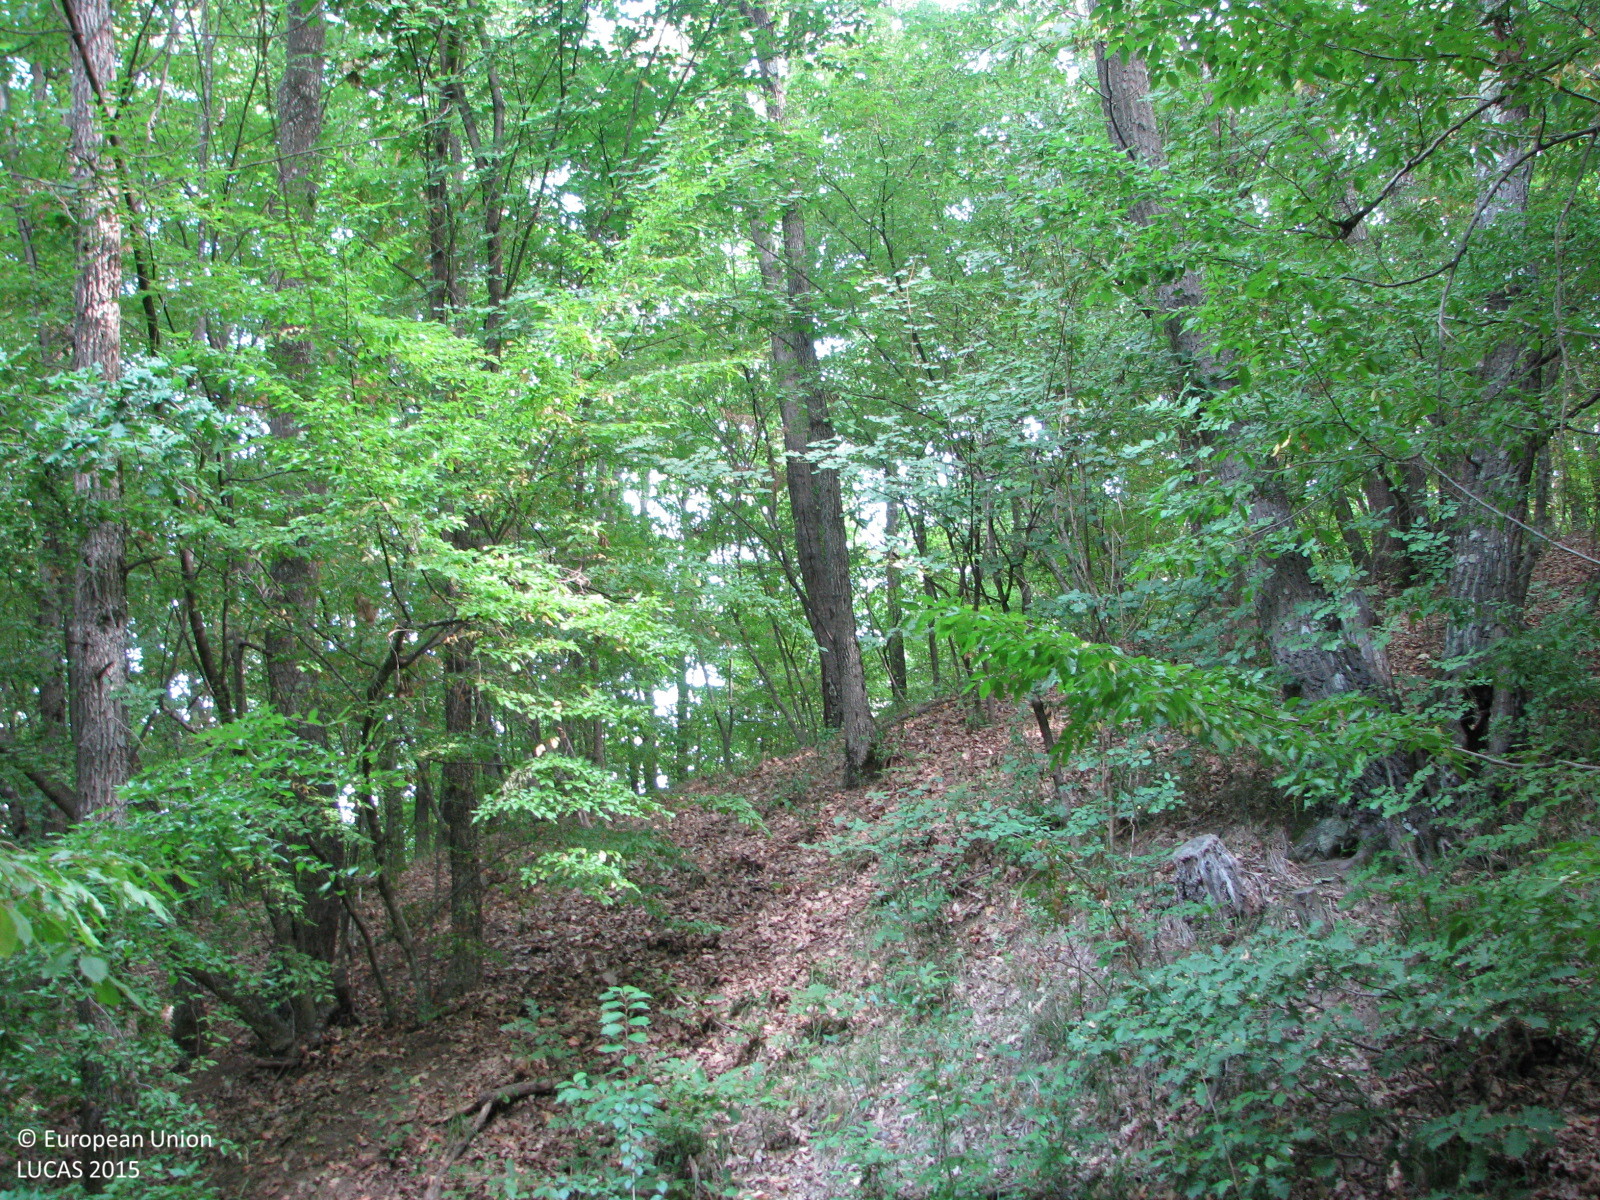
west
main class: Woodland
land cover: Broadleaved woodland
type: beech forest
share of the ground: > 75 %
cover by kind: broadleaved forest trees 75 %, consolidated bare surface 25 %
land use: Forestry
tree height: > 5 m
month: August
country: BG
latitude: 42.7075
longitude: 26.2663
